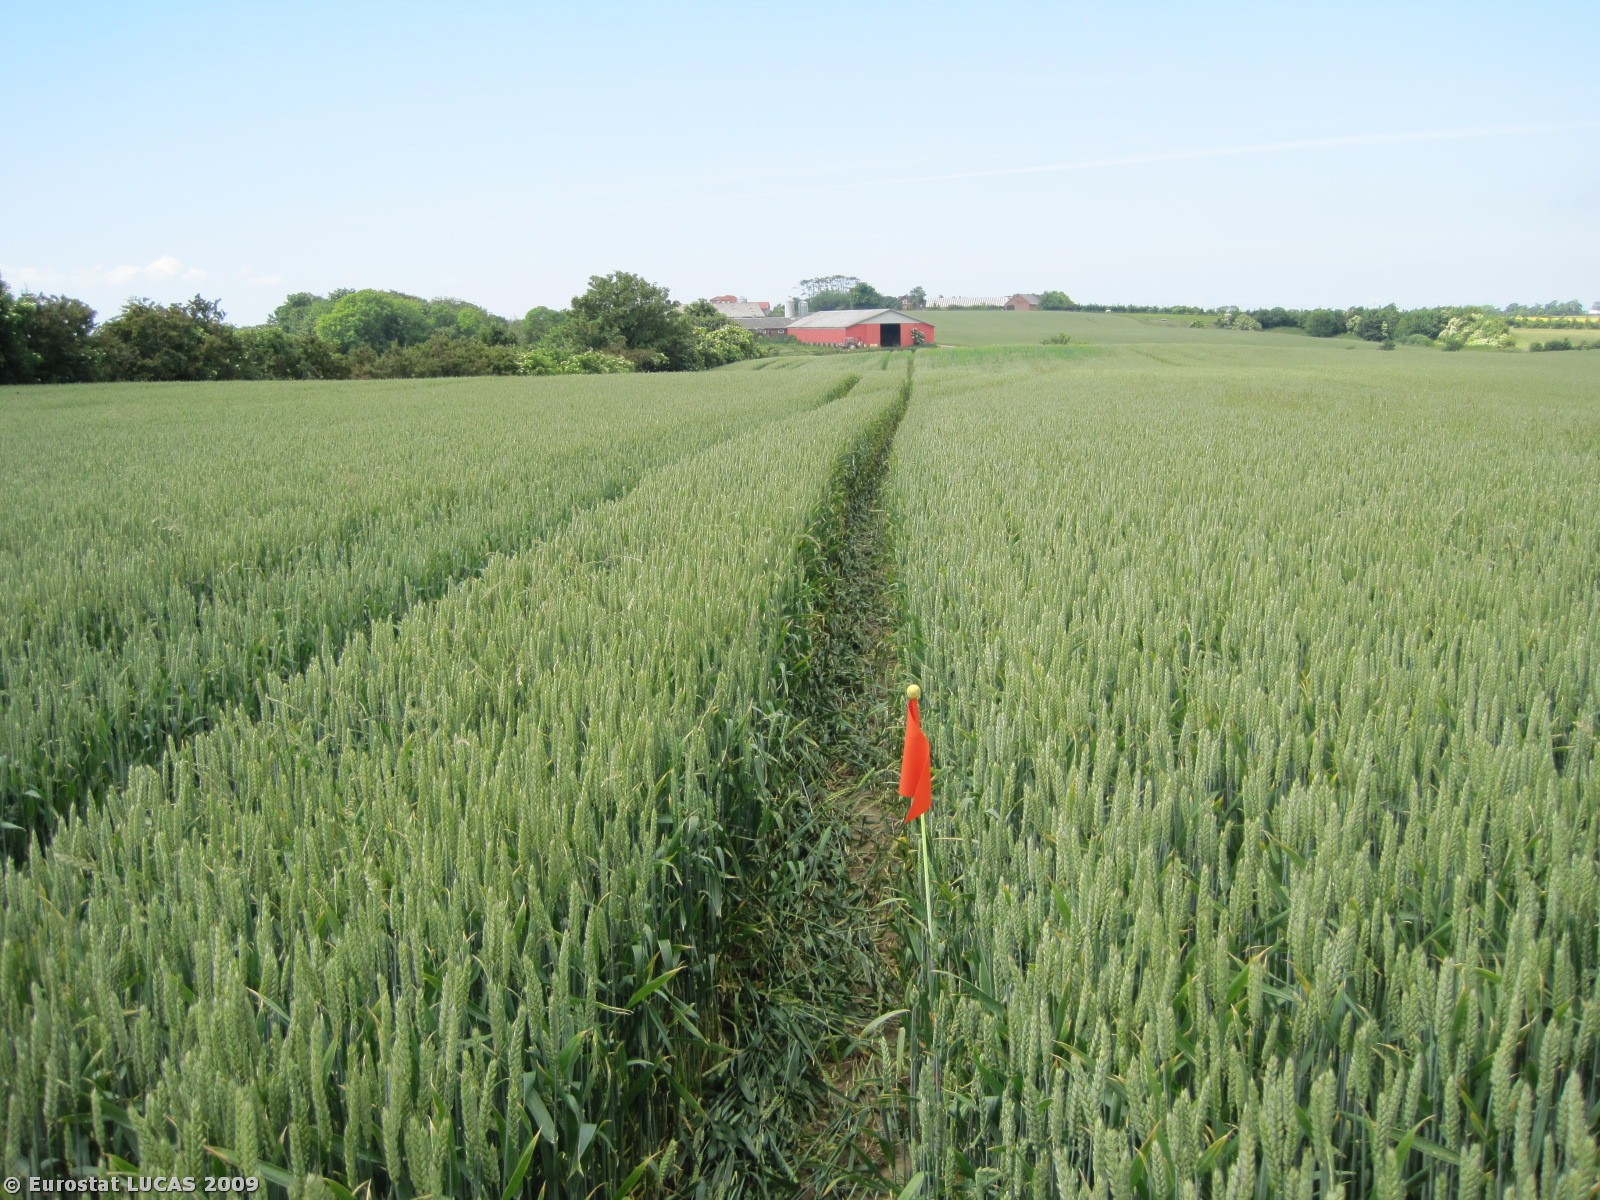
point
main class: Cropland
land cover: Common wheat
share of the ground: > 75 %
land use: Agriculture (excluding fallow land and kitchen gardens)
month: June
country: DK
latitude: 56.5775
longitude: 8.7807
